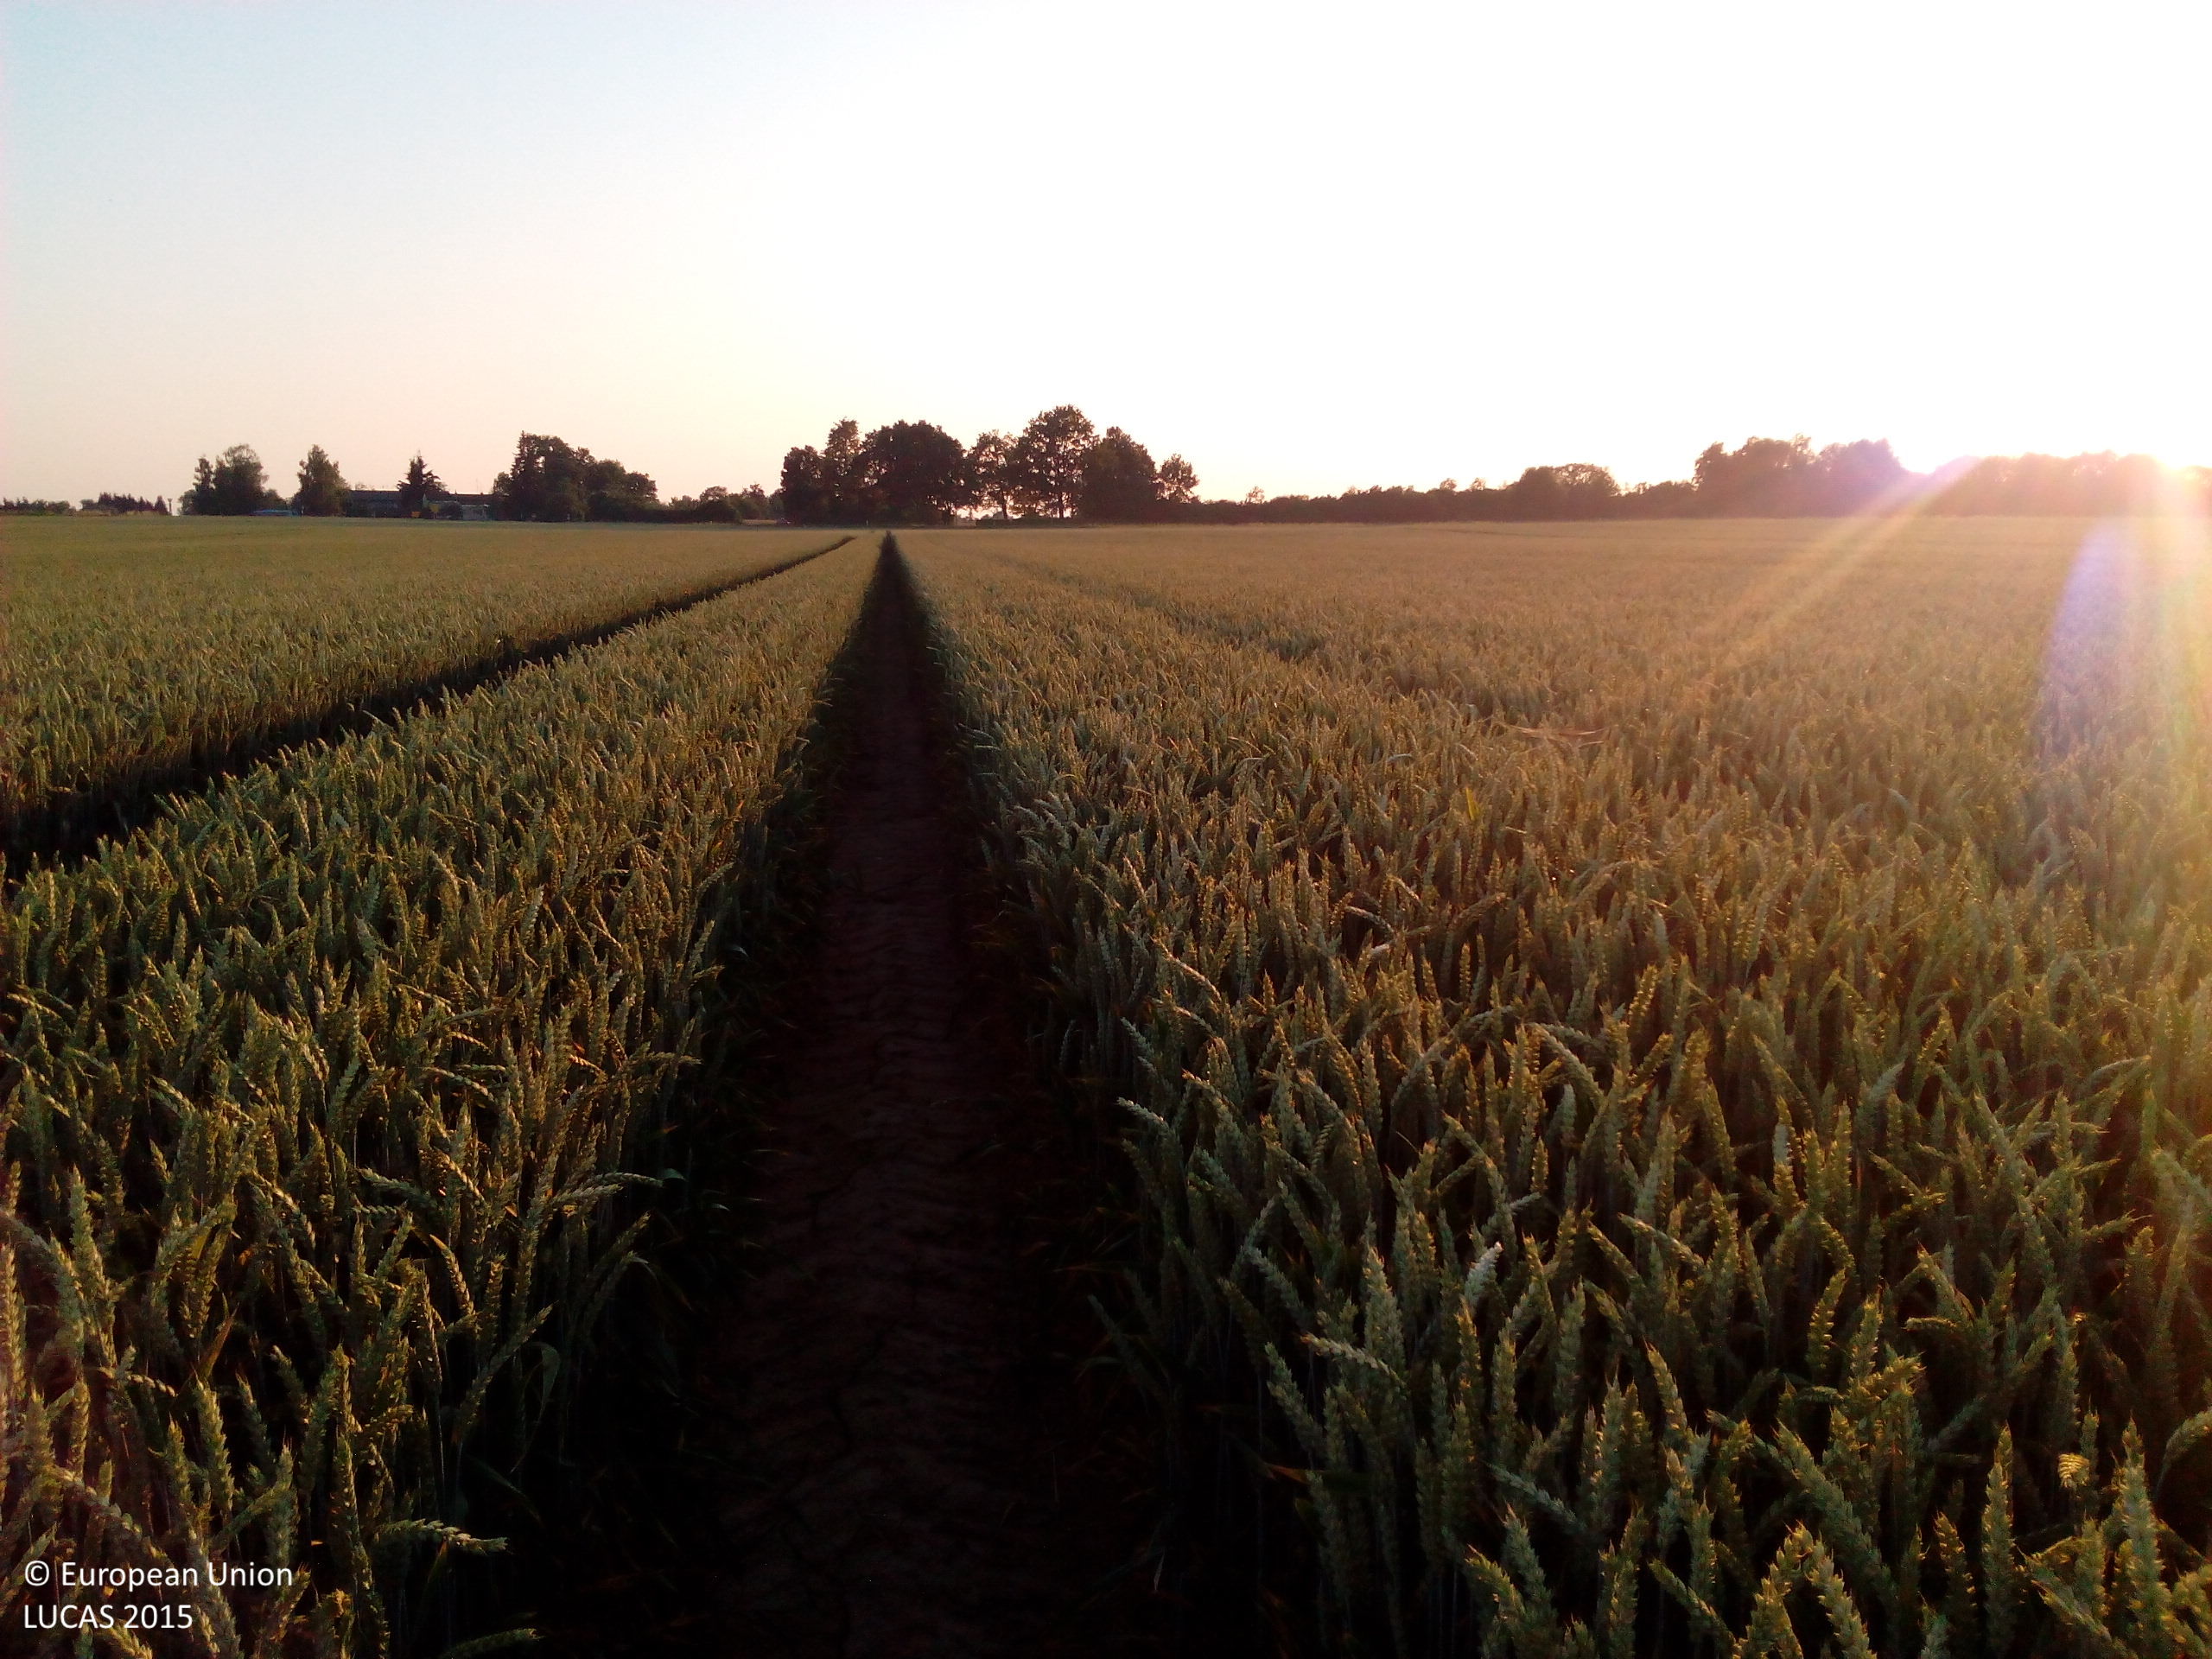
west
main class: Cropland
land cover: Common wheat
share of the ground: > 75 %
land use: Agriculture (excluding fallow land and kitchen gardens)
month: July
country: DE
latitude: 48.7422
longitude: 12.9503
